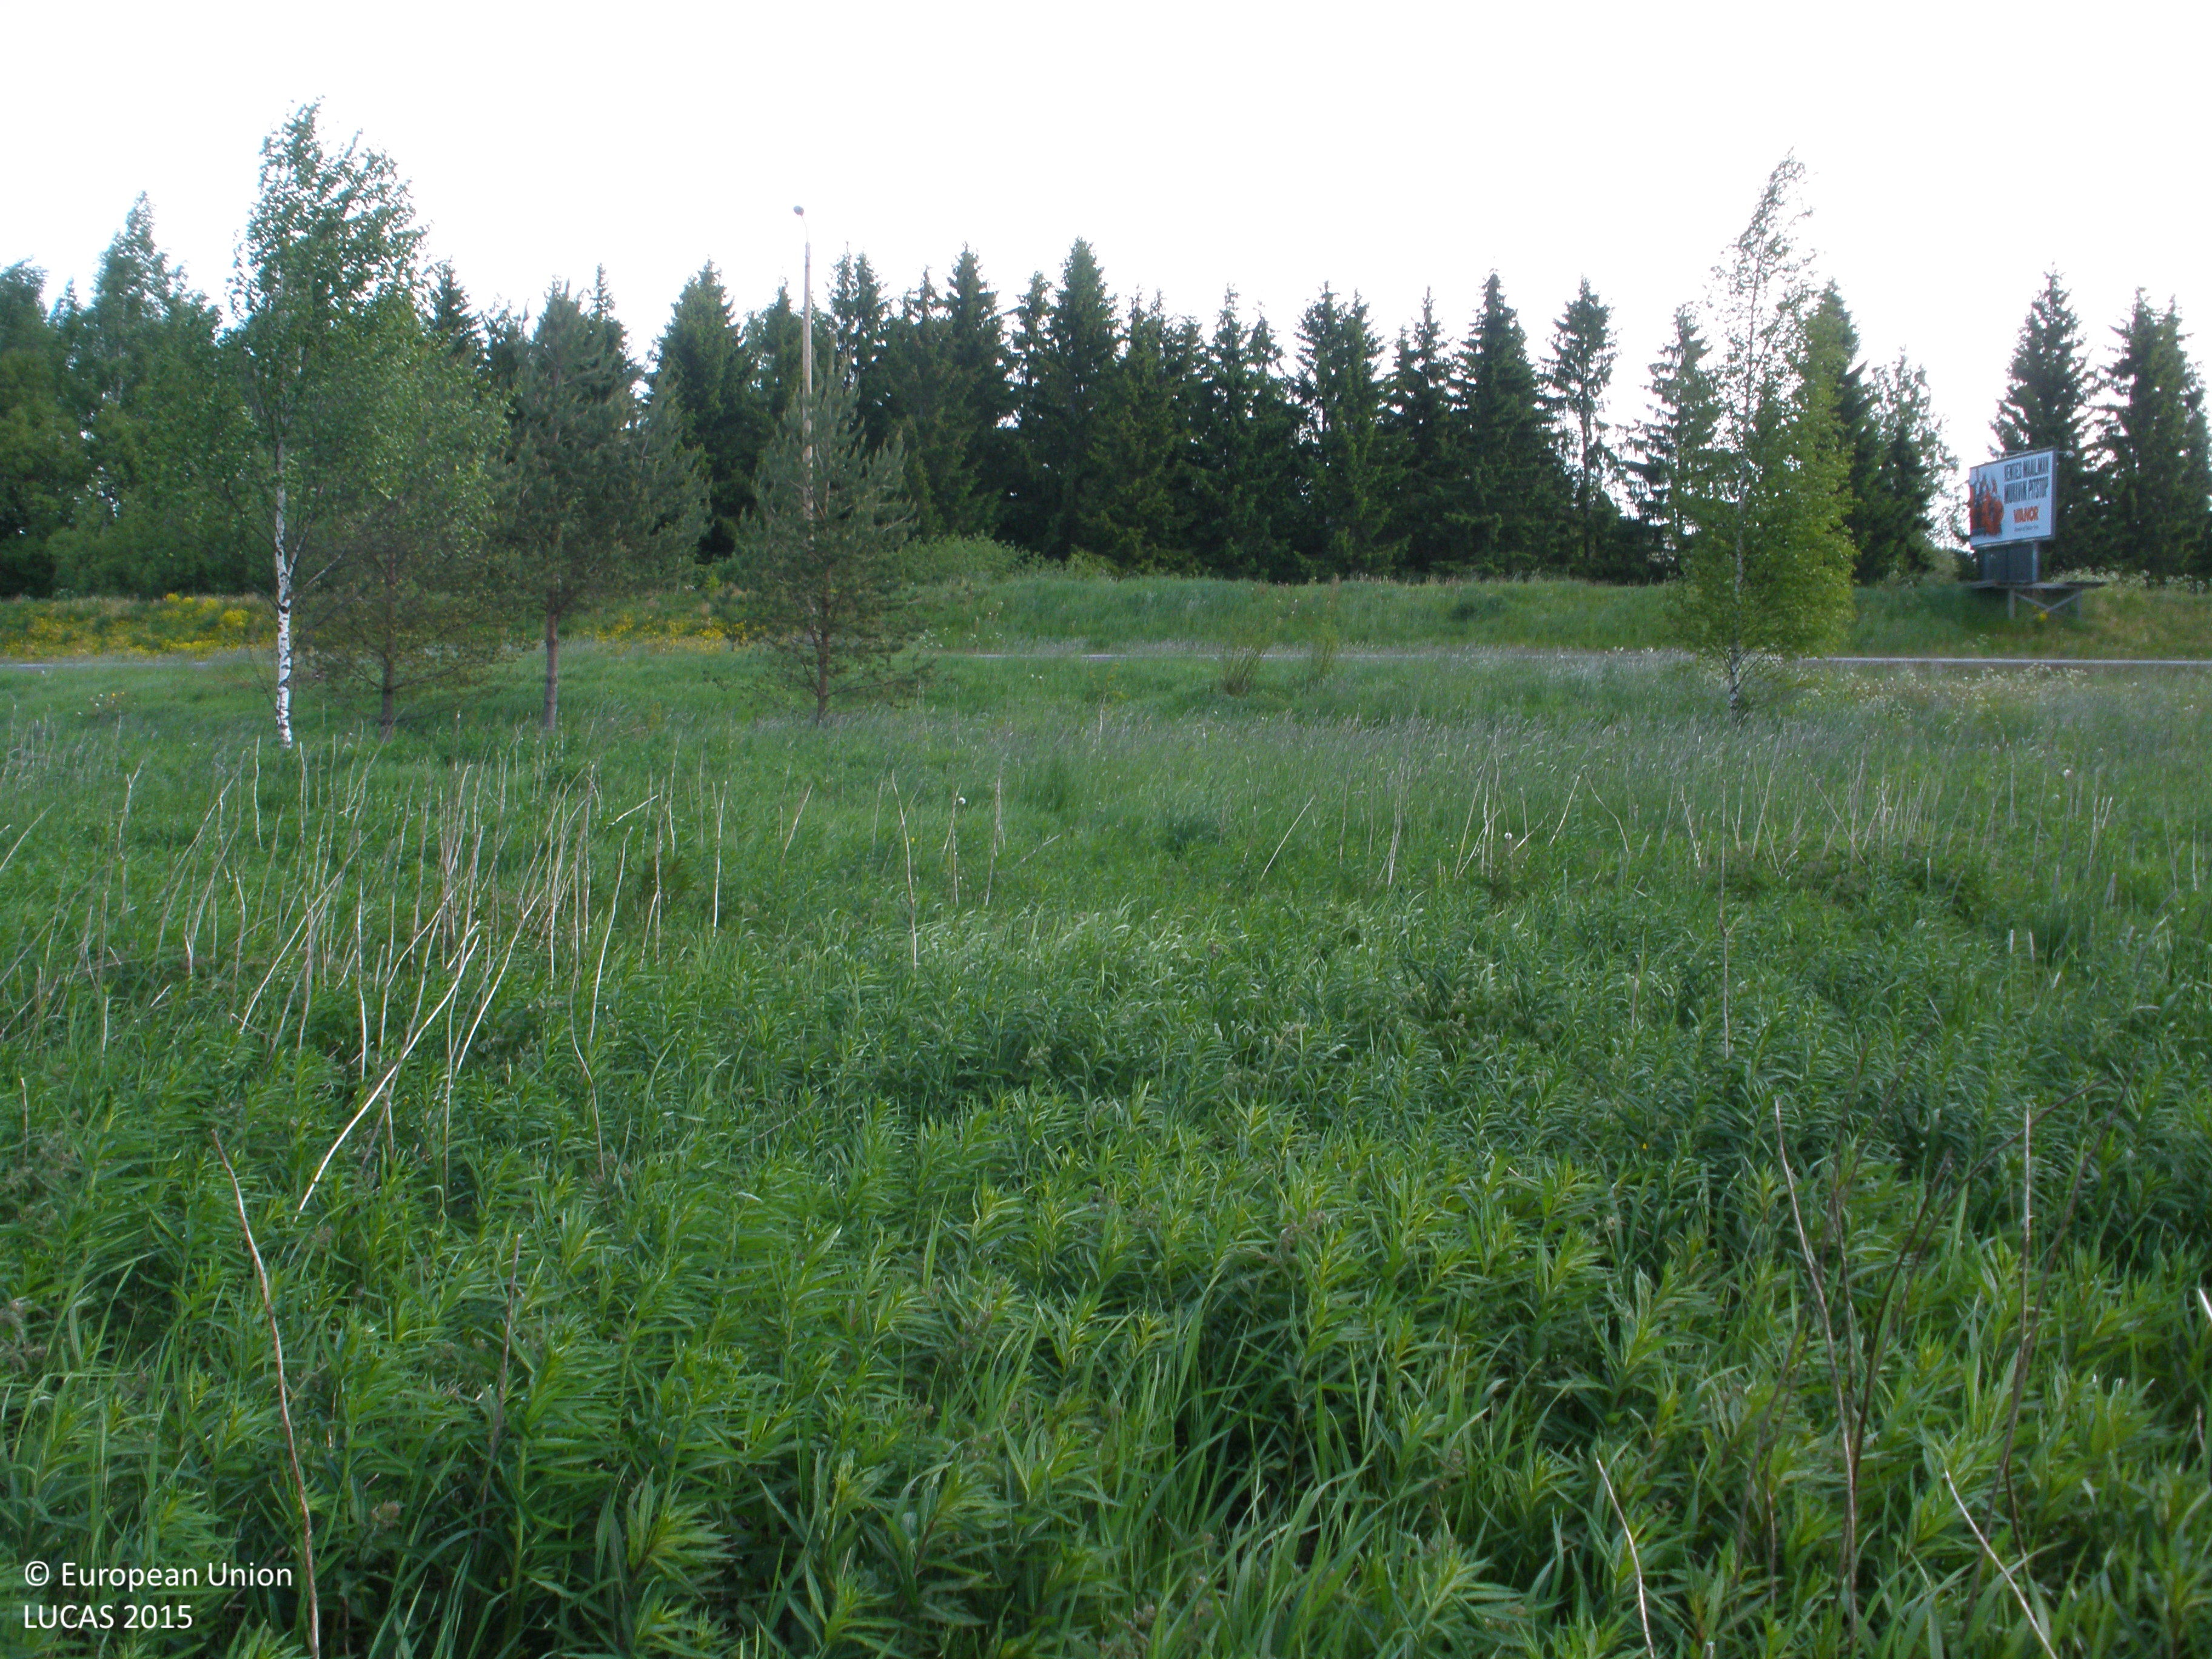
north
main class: Grassland
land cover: Grassland with sparse tree/shrub cover
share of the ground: > 75 %
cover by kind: herbaceous plants 90 %, broadleaved forest trees 5 %, shrubs 5 %
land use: Semi-natural and natural areas not in use
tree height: > 5 m
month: June
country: FI
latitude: 60.7970
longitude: 23.6284
